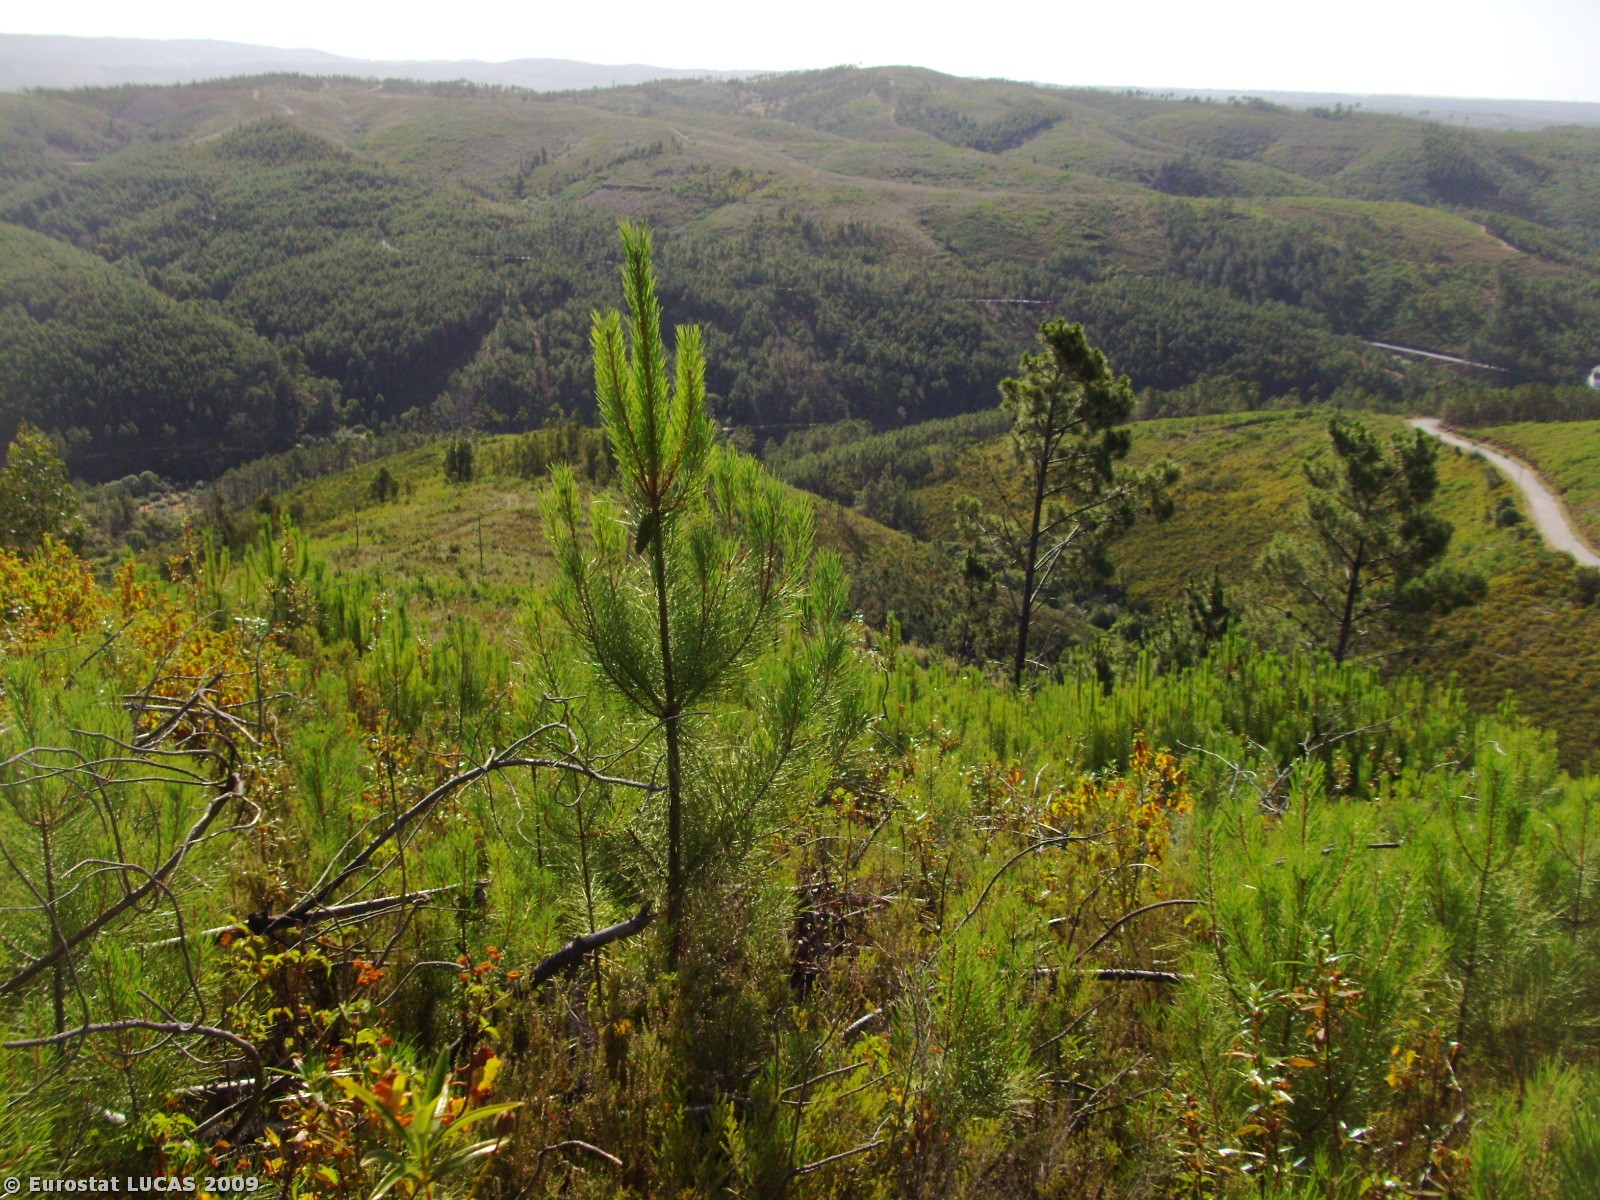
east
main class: Woodland
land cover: Coniferous woodland
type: coniferous forest of the mediterranean region
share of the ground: > 75 %
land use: Forestry
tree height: > 5 m
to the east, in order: Coniferous woodland; Paved roads, cycling and walking lanes; Coniferous woodland; Electric lines; Coniferous woodland
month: June
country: PT
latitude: 40.0157
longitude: -7.6690
